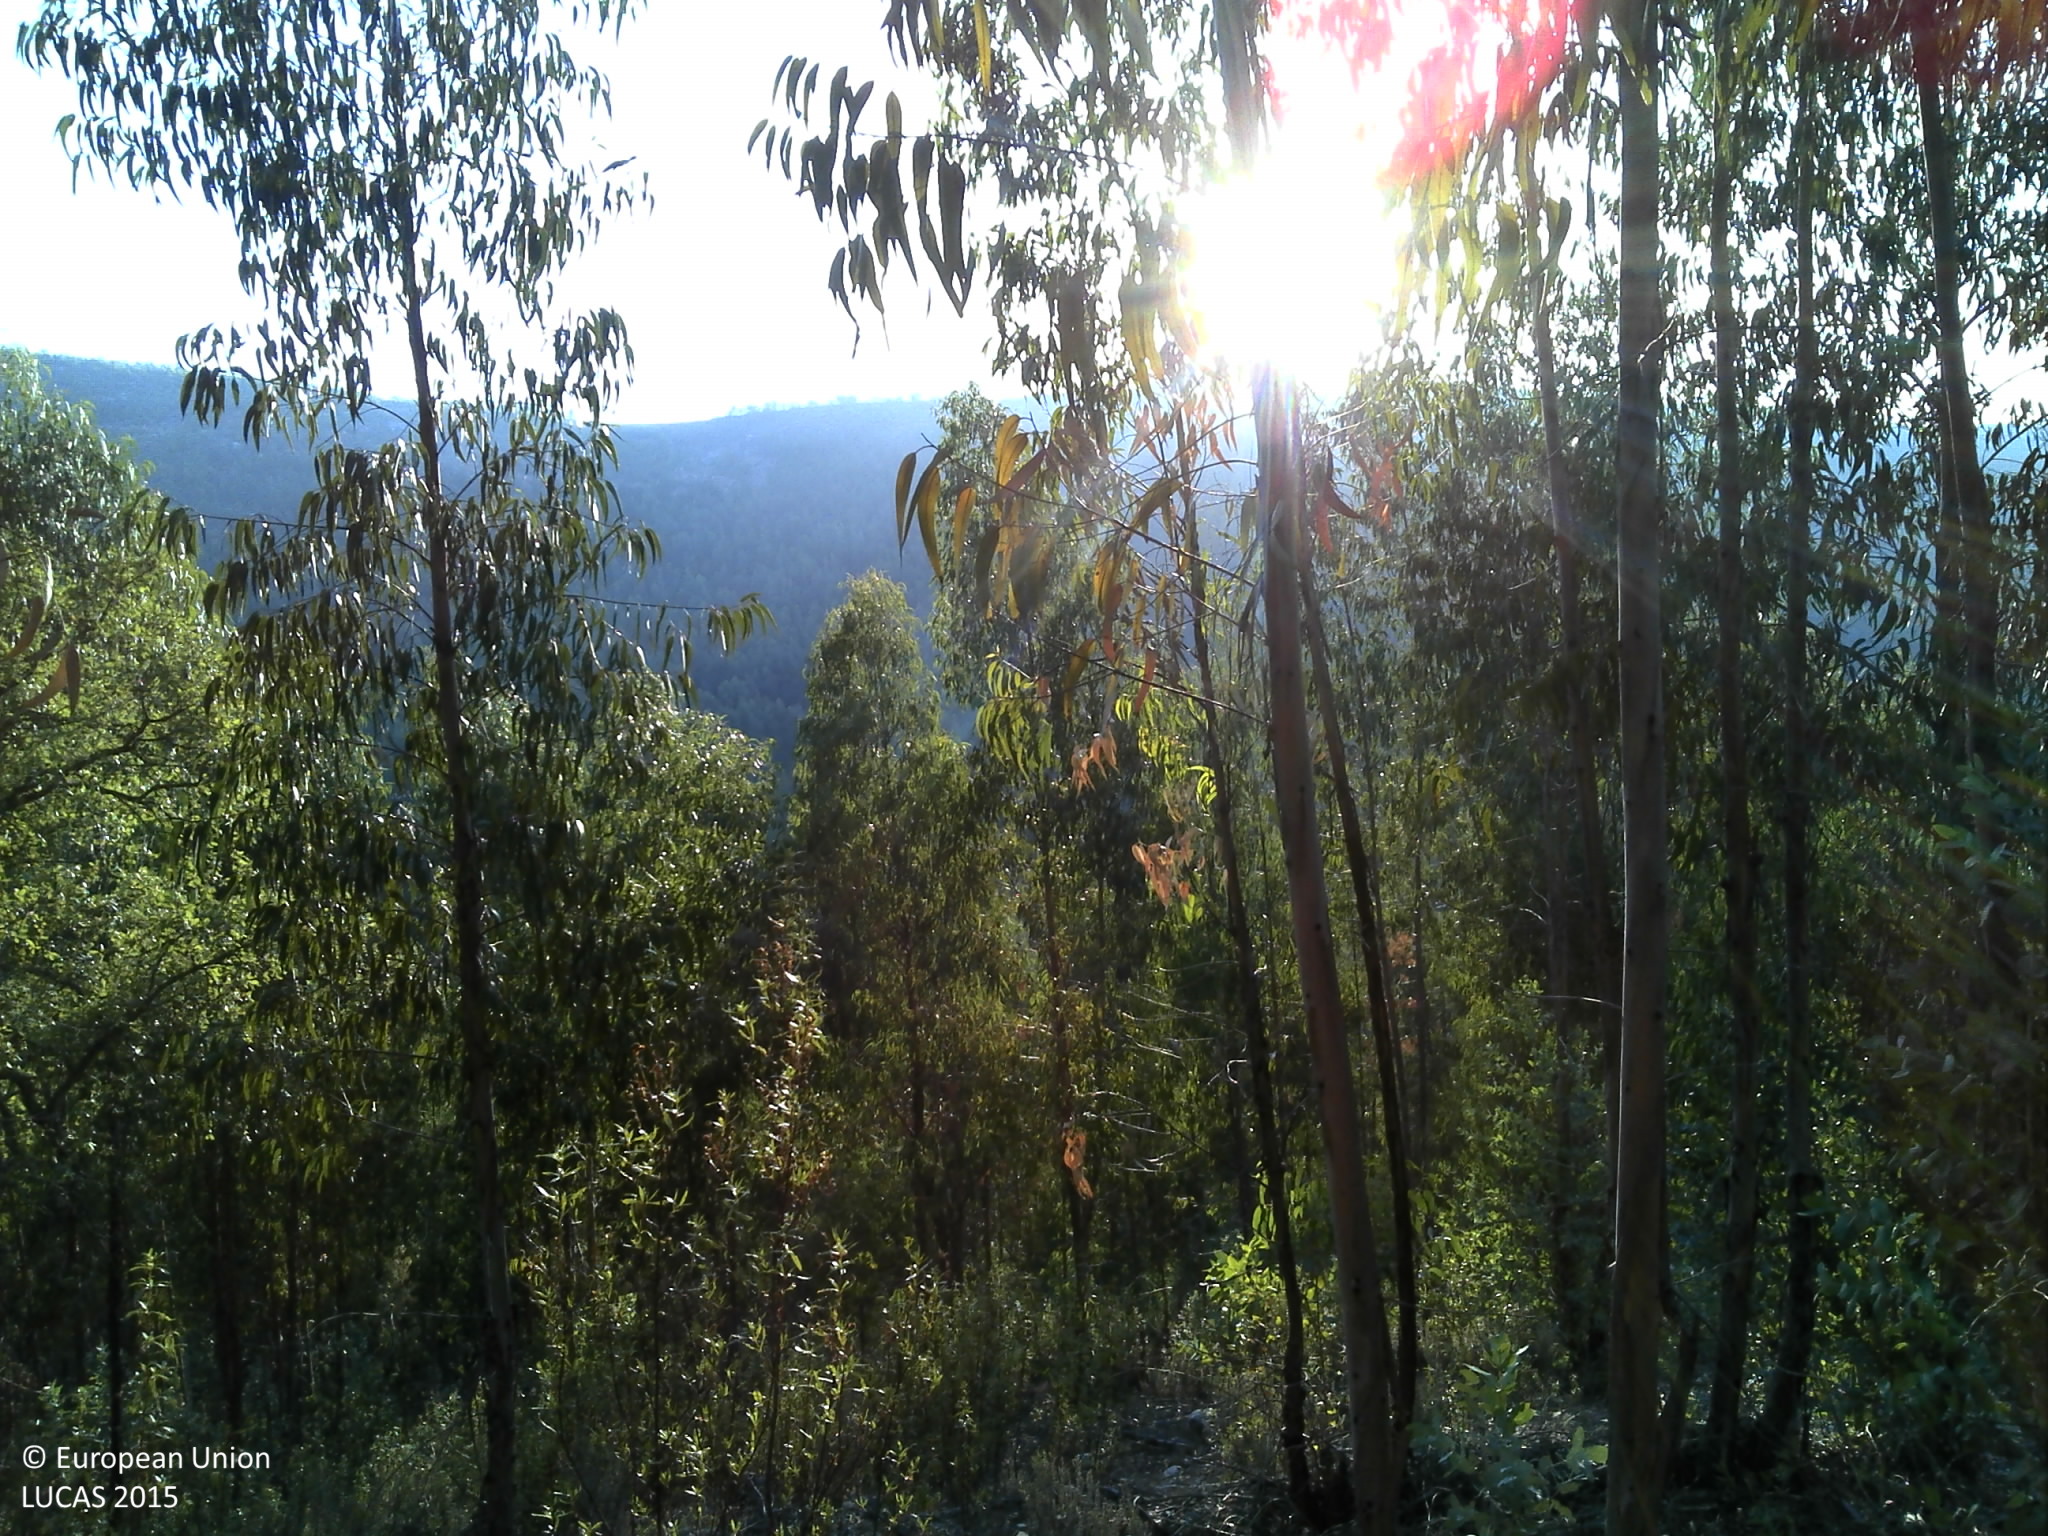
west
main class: Woodland
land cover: Broadleaved woodland
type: exotic forest
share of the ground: > 75 %
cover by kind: broadleaved forest trees 75 %, shrubs 25 %
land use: Forestry
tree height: > 5 m
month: August
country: PT
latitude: 39.6127
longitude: -7.6523
